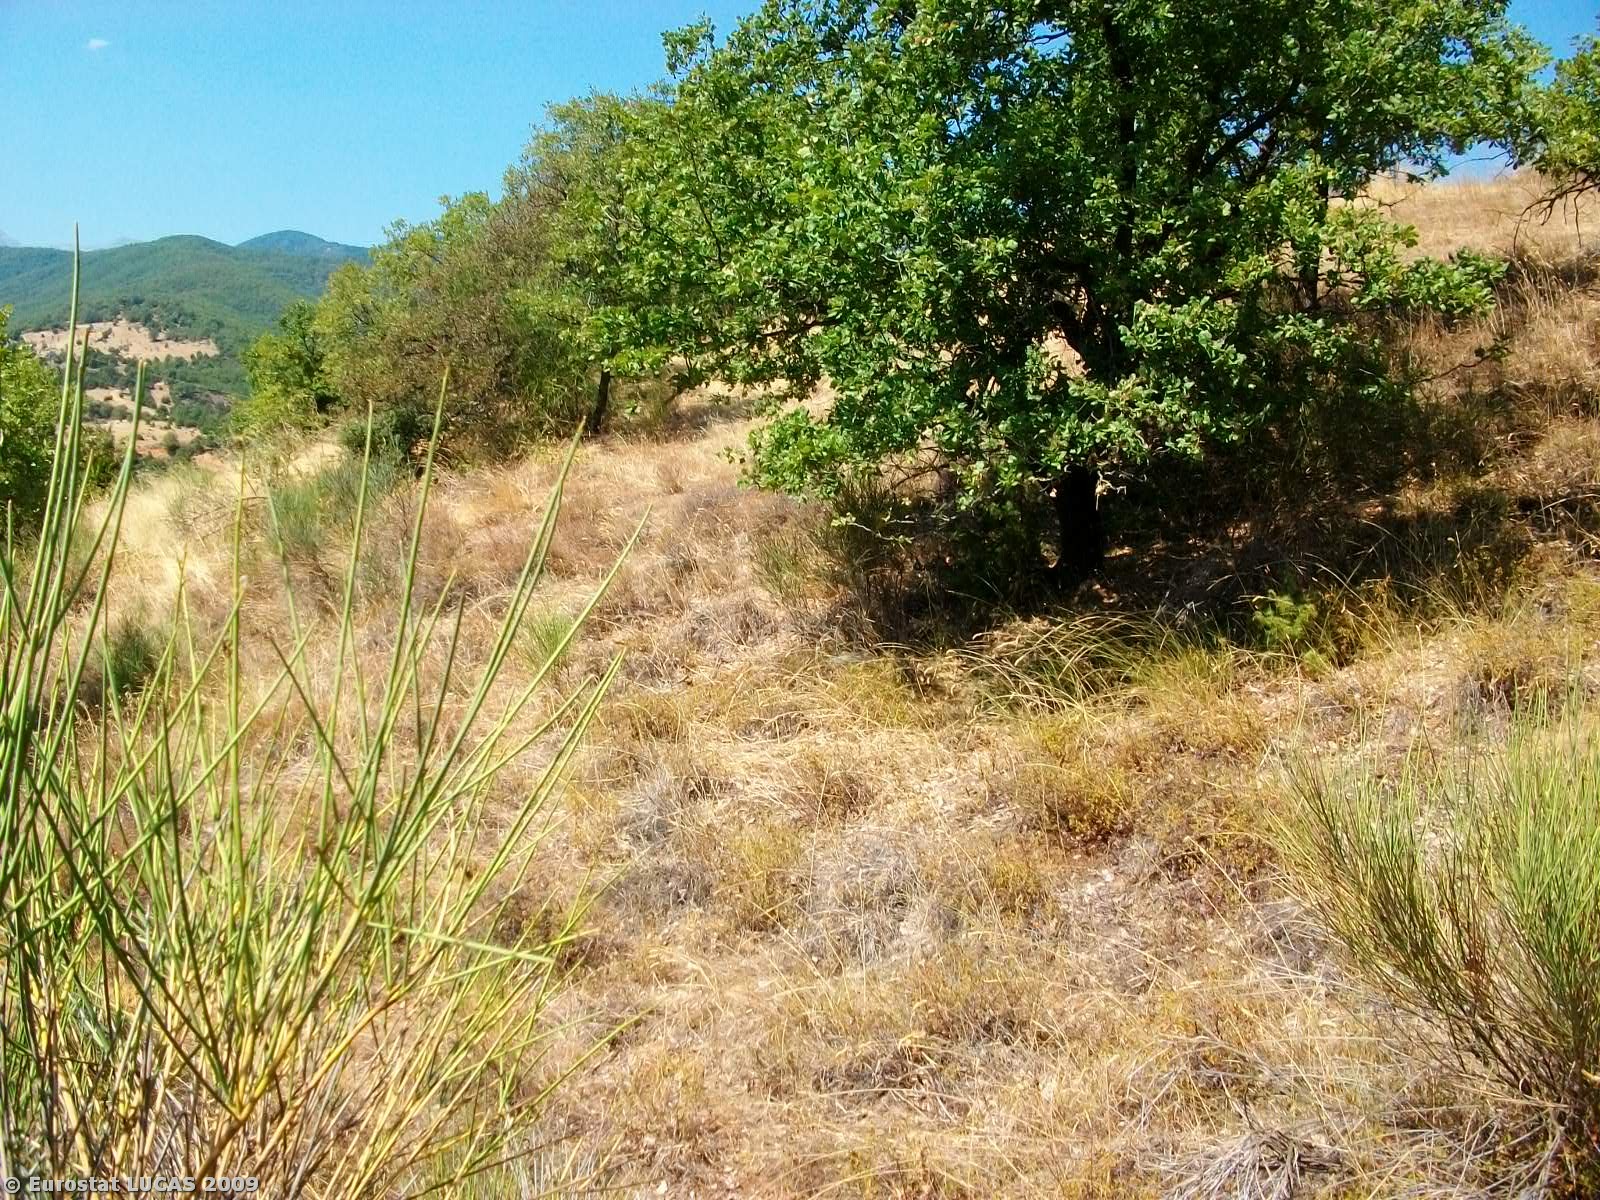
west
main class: Woodland
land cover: Mixed woodland
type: coniferous forest of the mediterranean region
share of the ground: 50 - 75 %
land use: Forestry
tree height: > 5 m
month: August
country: GR
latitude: 38.7258
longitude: 22.4124
